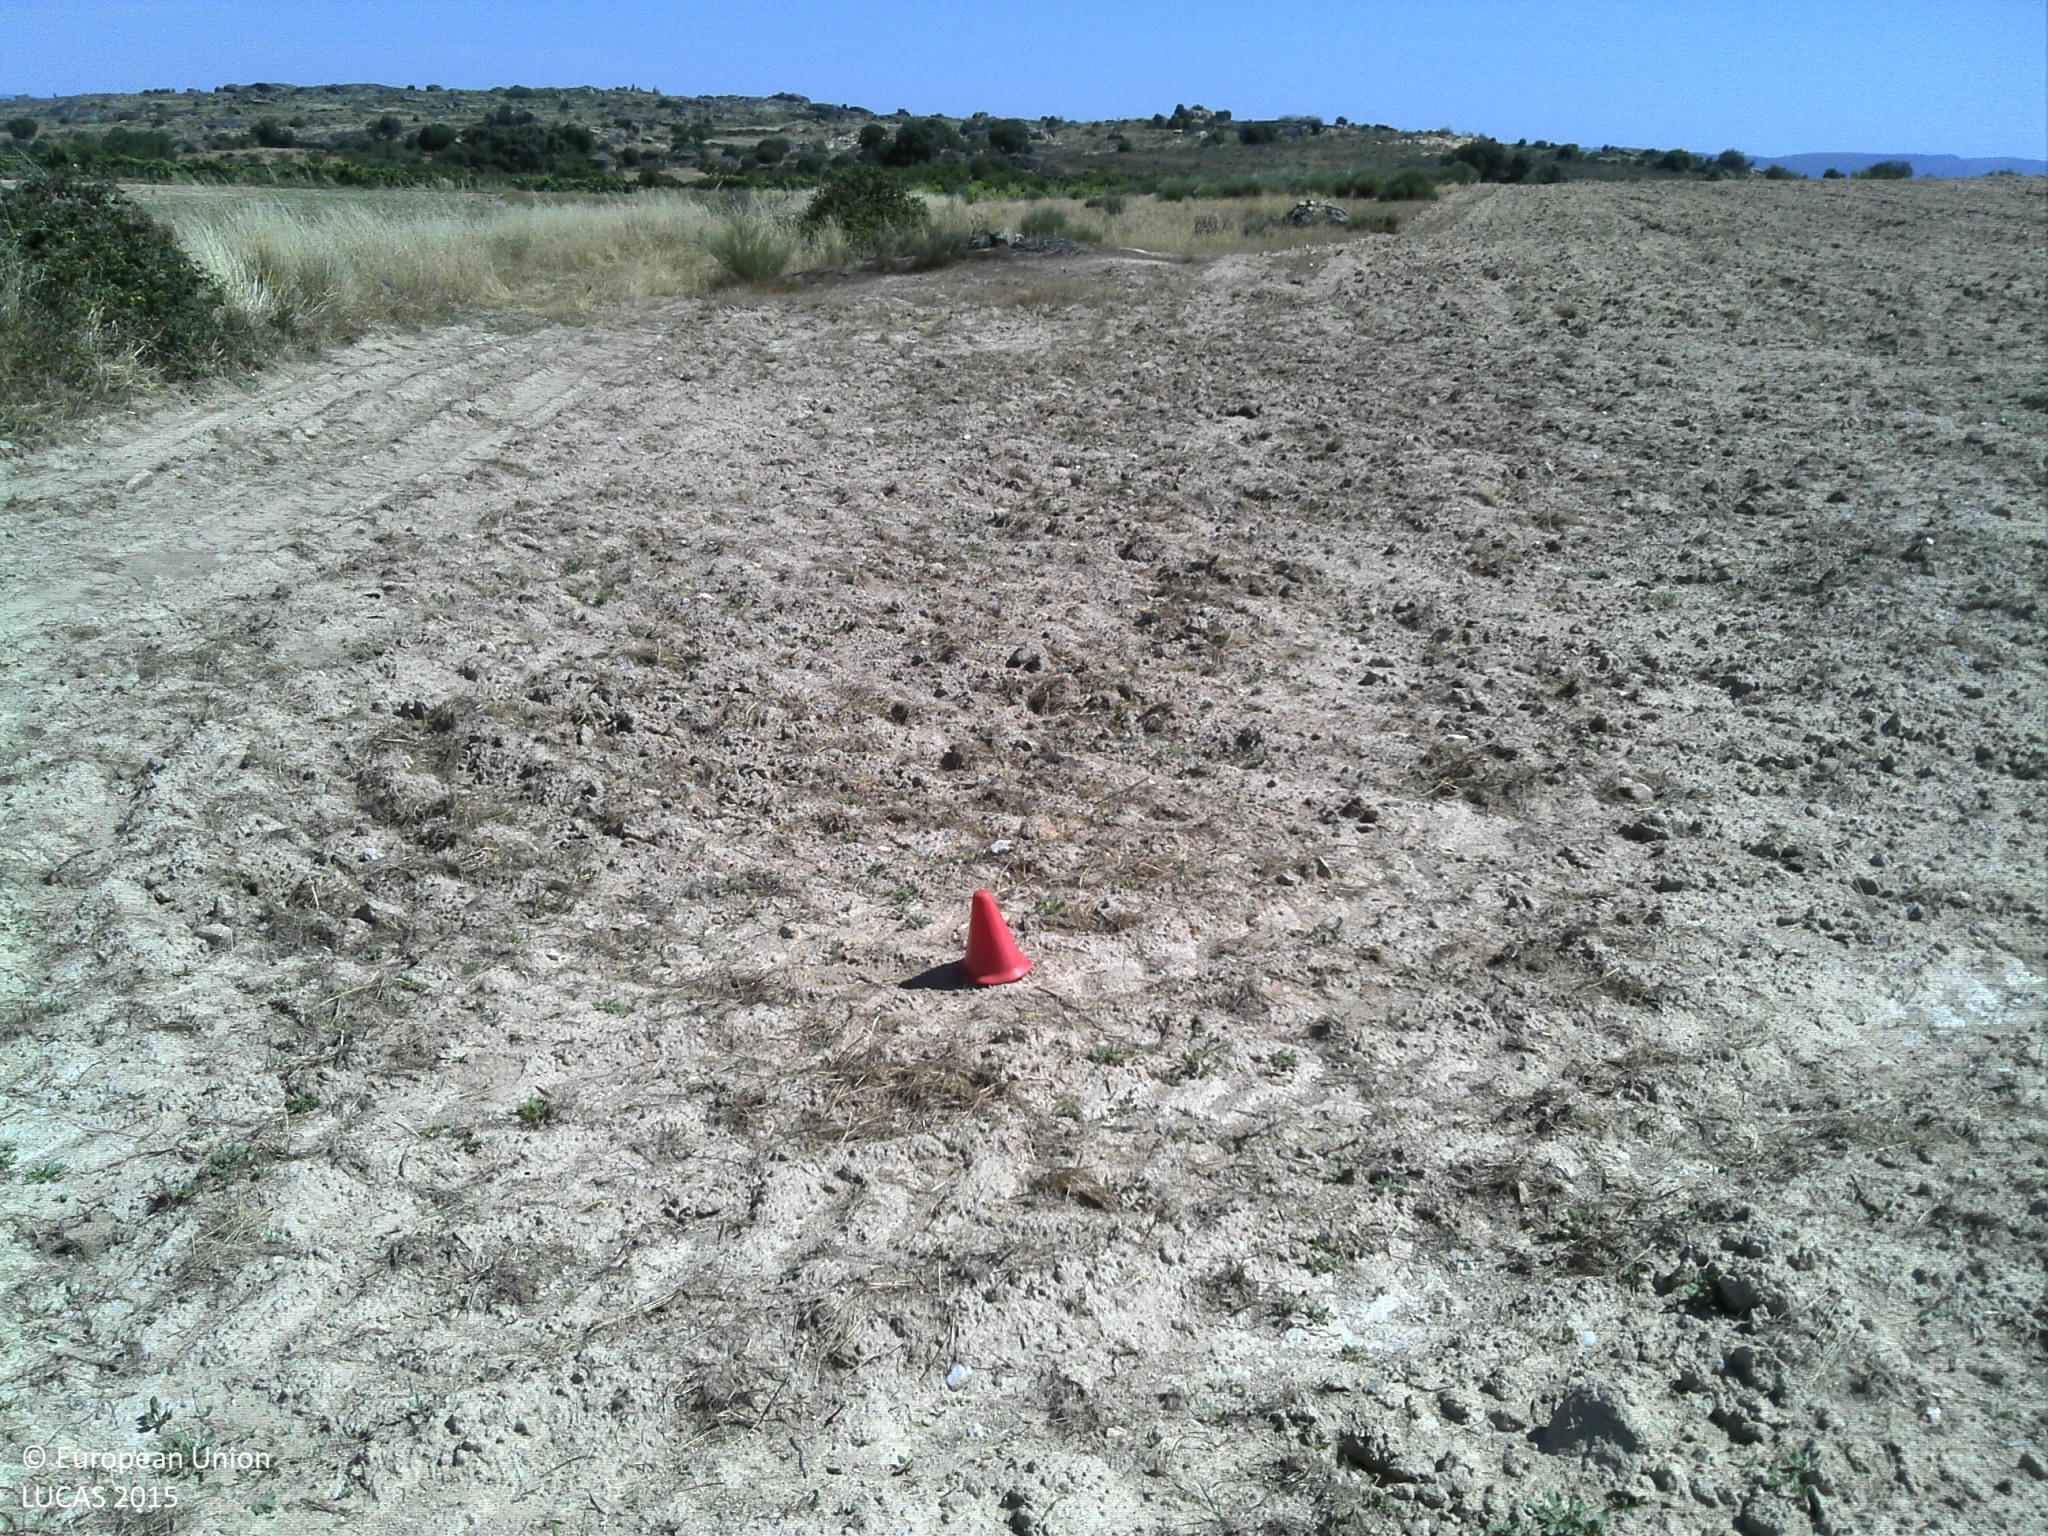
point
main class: Cropland
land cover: Durum wheat
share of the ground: < 10 %
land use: Agriculture (excluding fallow land and kitchen gardens)
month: June
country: PT
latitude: 40.9611
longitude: -6.9166
